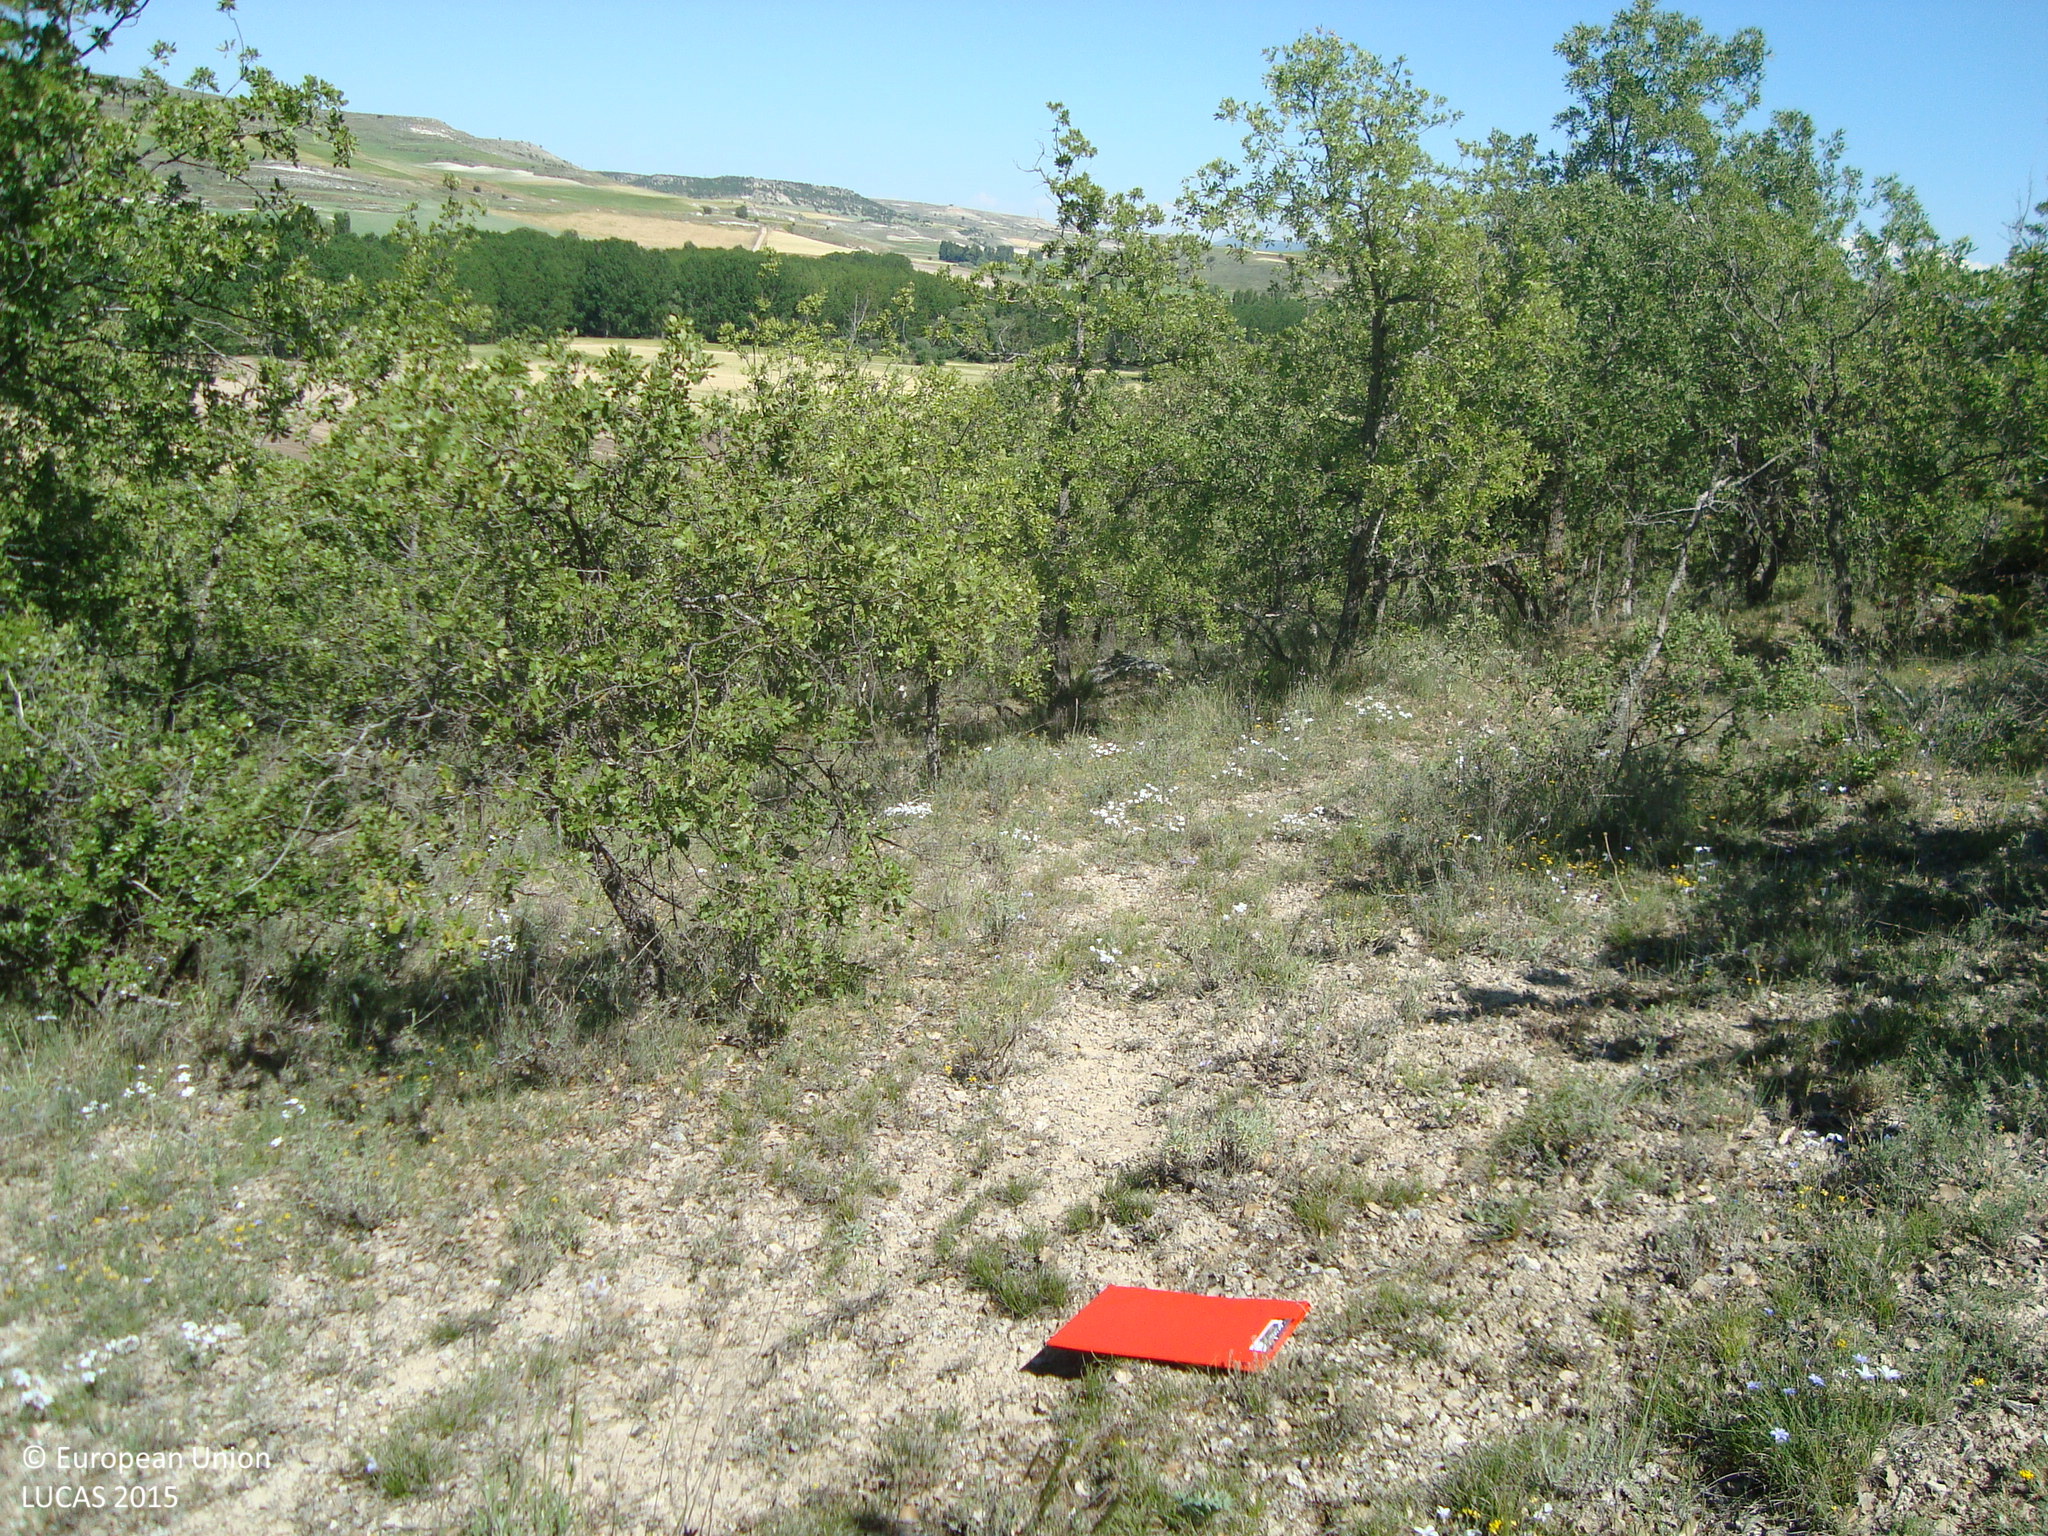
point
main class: Woodland
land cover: Broadleaved woodland
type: thermophilous deciduous forest
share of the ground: 50 - 75 %
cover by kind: broadleaved forest trees 55 %, herbaceous plants 25 %, shrubs 20 %
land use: Semi-natural and natural areas not in use
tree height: < 5 m
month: May
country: ES
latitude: 41.5062
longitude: -4.0374
